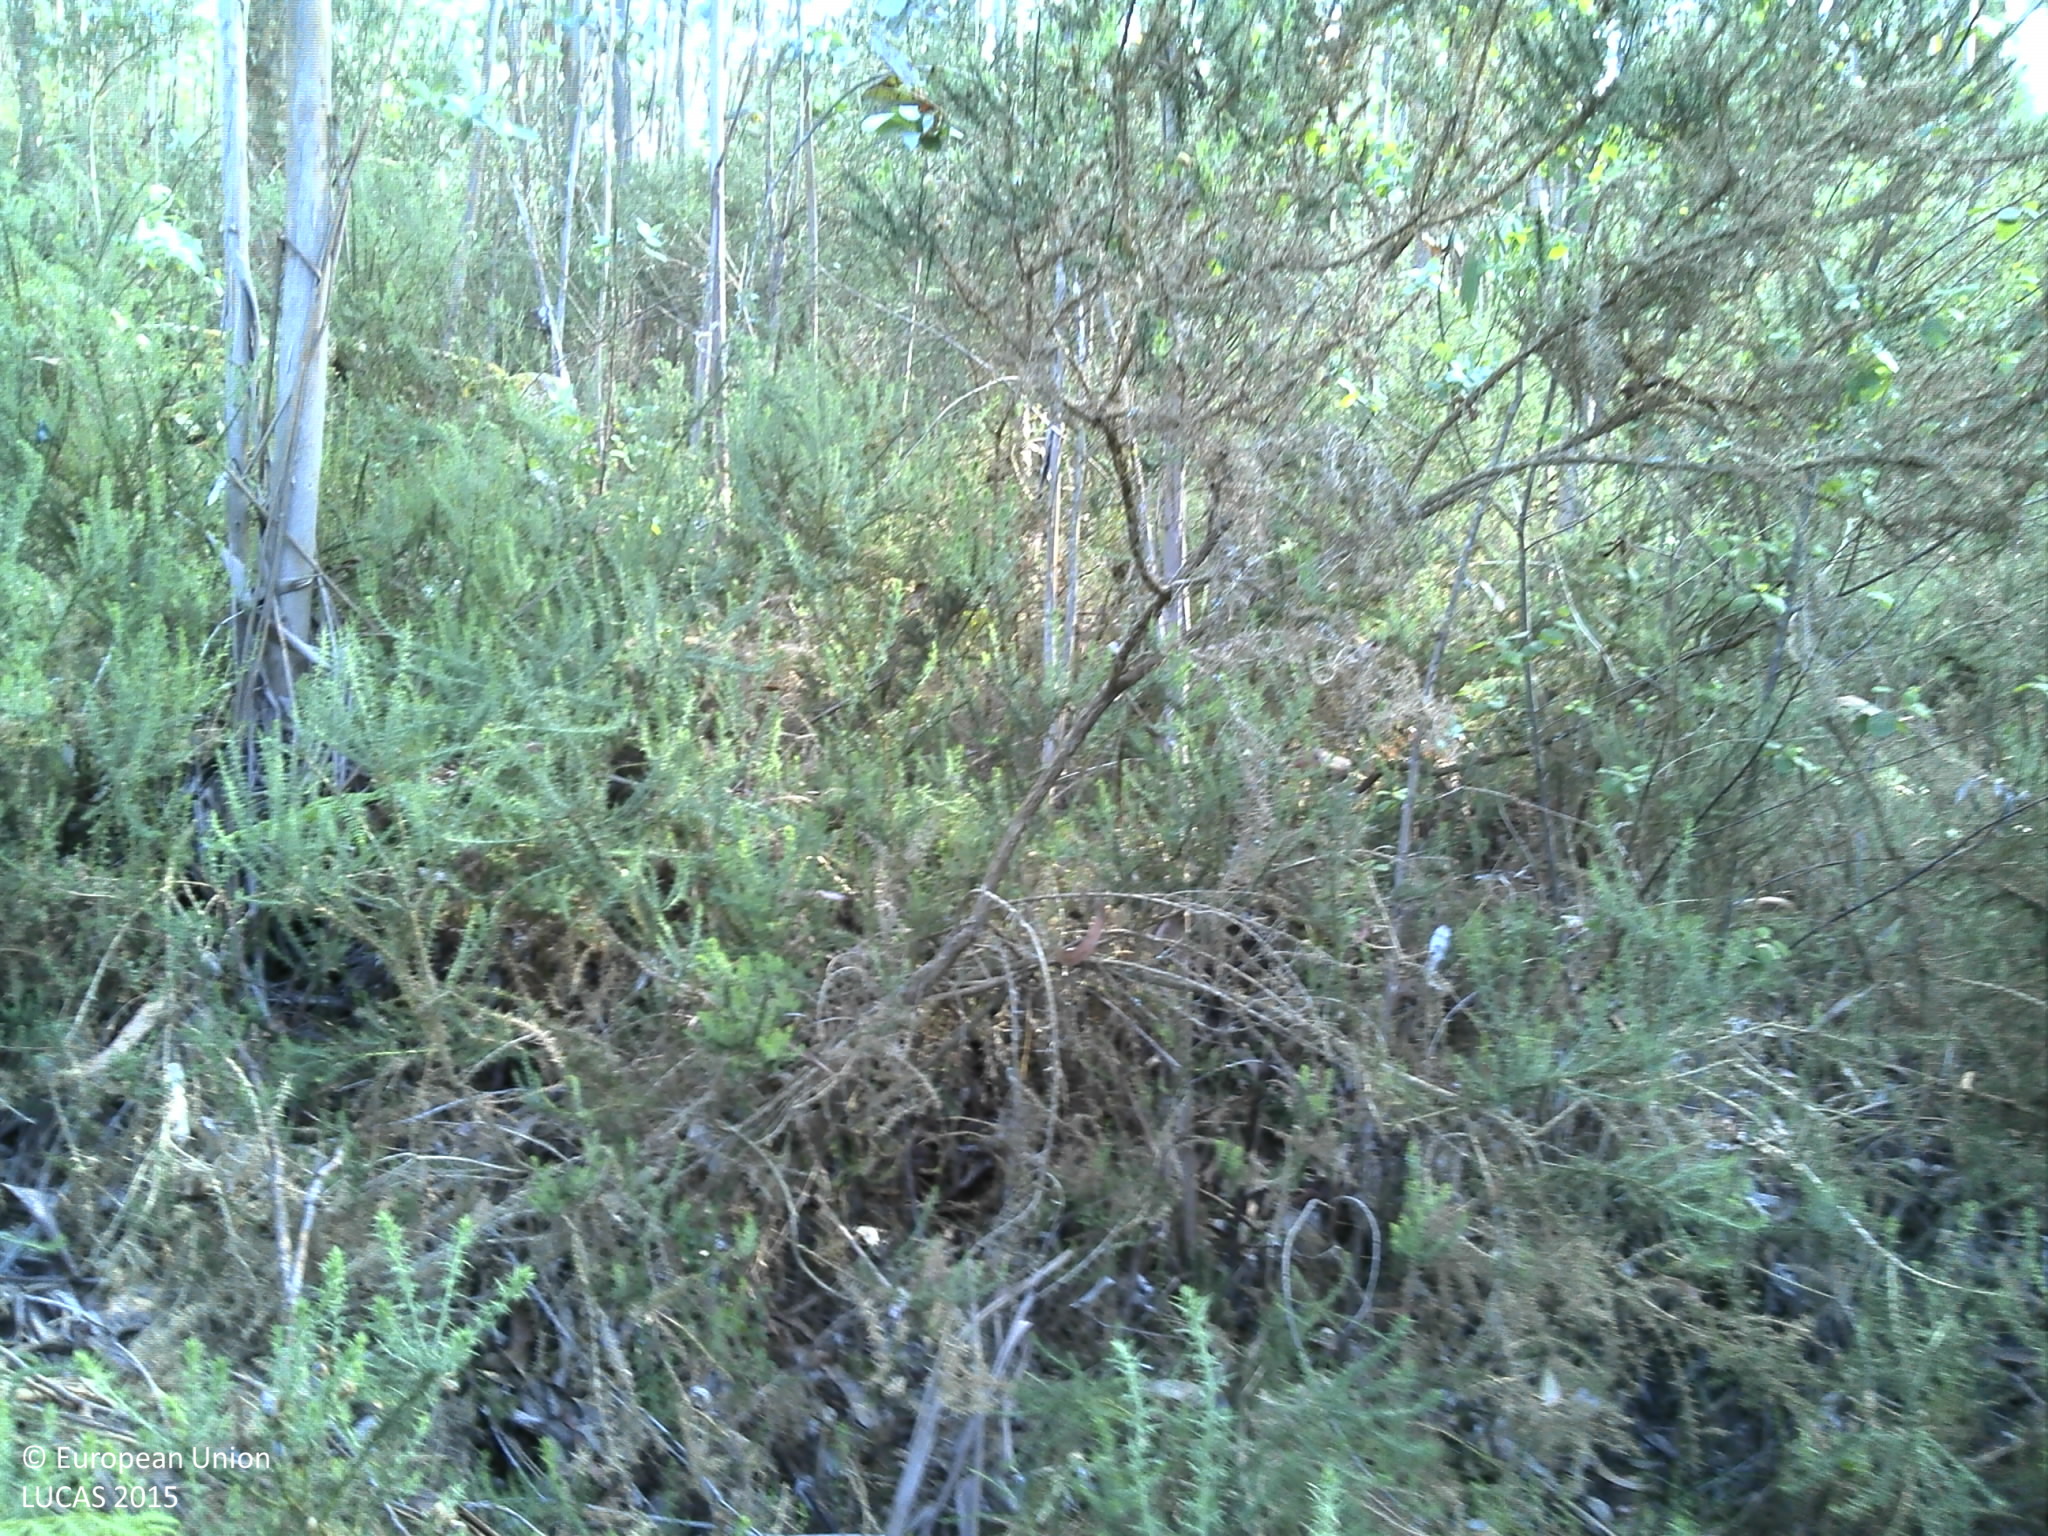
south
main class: Woodland
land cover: Broadleaved woodland
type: exotic forest
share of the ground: 50 - 75 %
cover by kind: broadleaved forest trees 80 %, shrubs 20 %
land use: Forestry
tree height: > 5 m
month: May
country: PT
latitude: 41.6840
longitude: -8.7261
